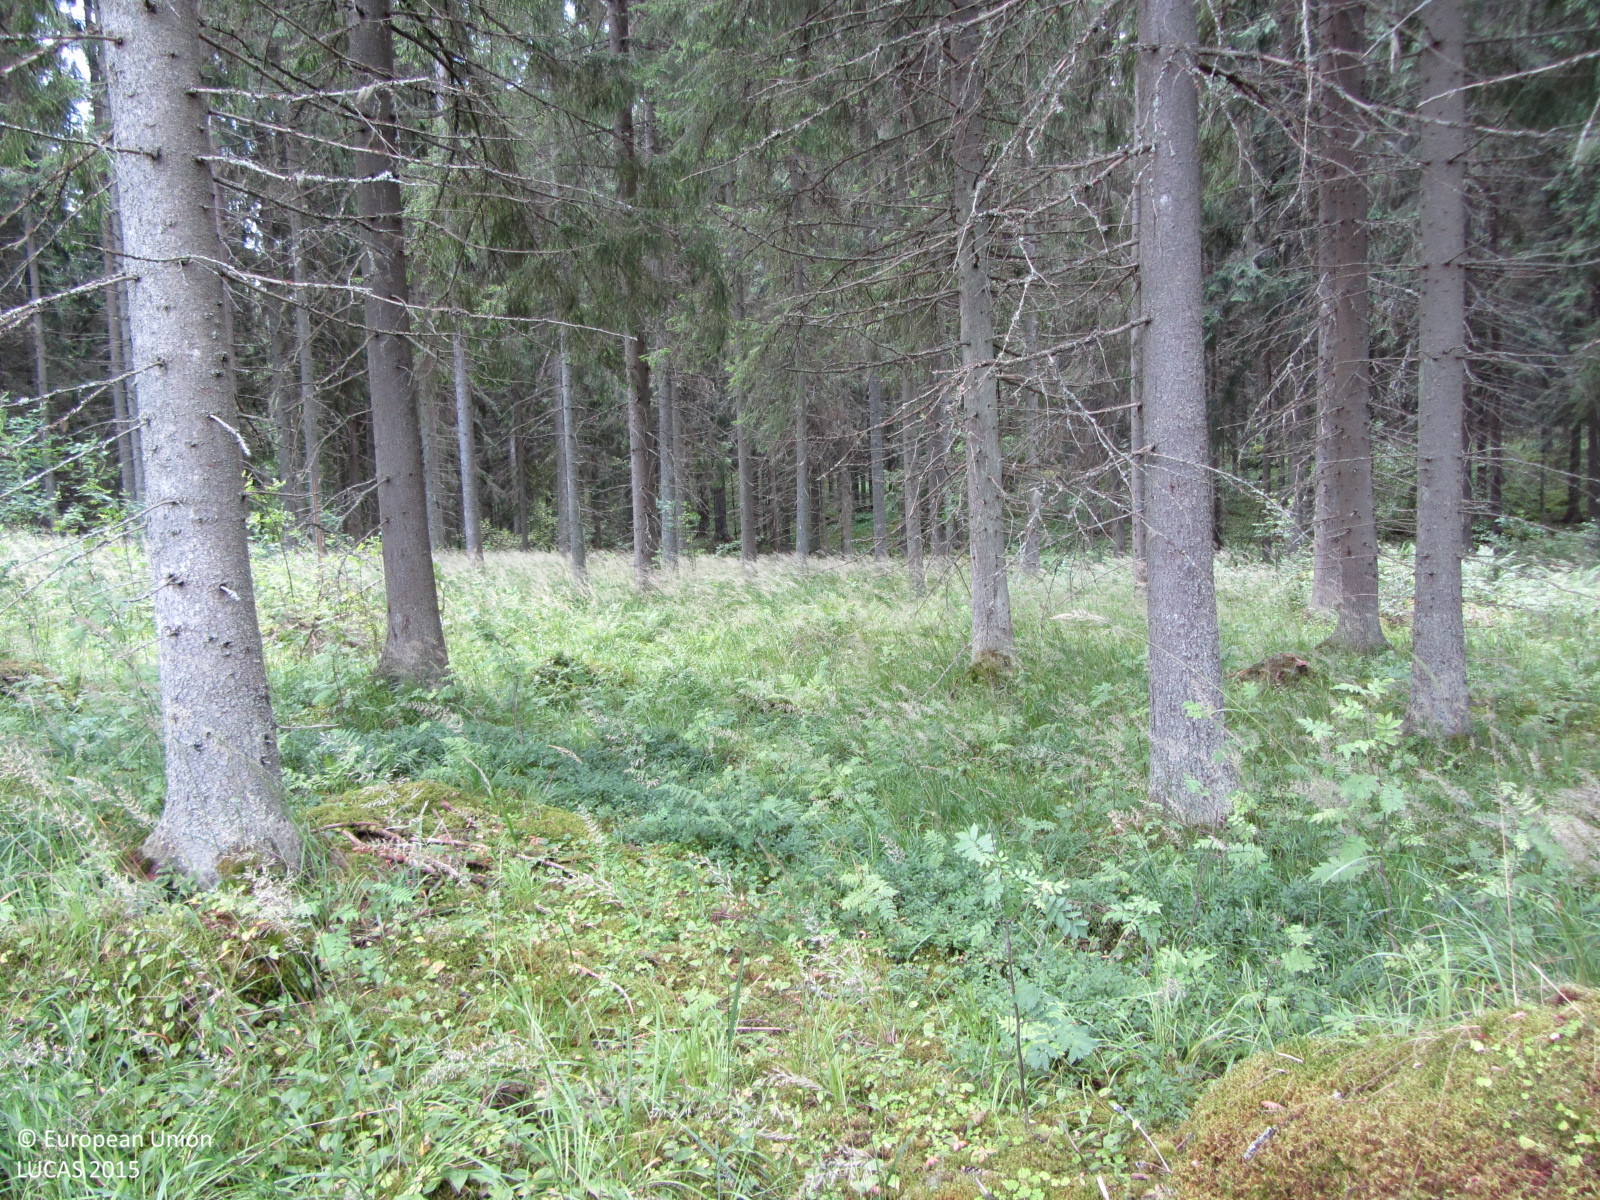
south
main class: Woodland
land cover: Spruce dominated coniferous woodland
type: boreal forest
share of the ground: > 75 %
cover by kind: coniferous forest trees 80 %, herbaceous plants 15 %, broadleaved forest trees 5 %
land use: Forestry
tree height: > 5 m
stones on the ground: 10 - 25 %
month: August
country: FI
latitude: 60.6932
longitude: 24.6686
